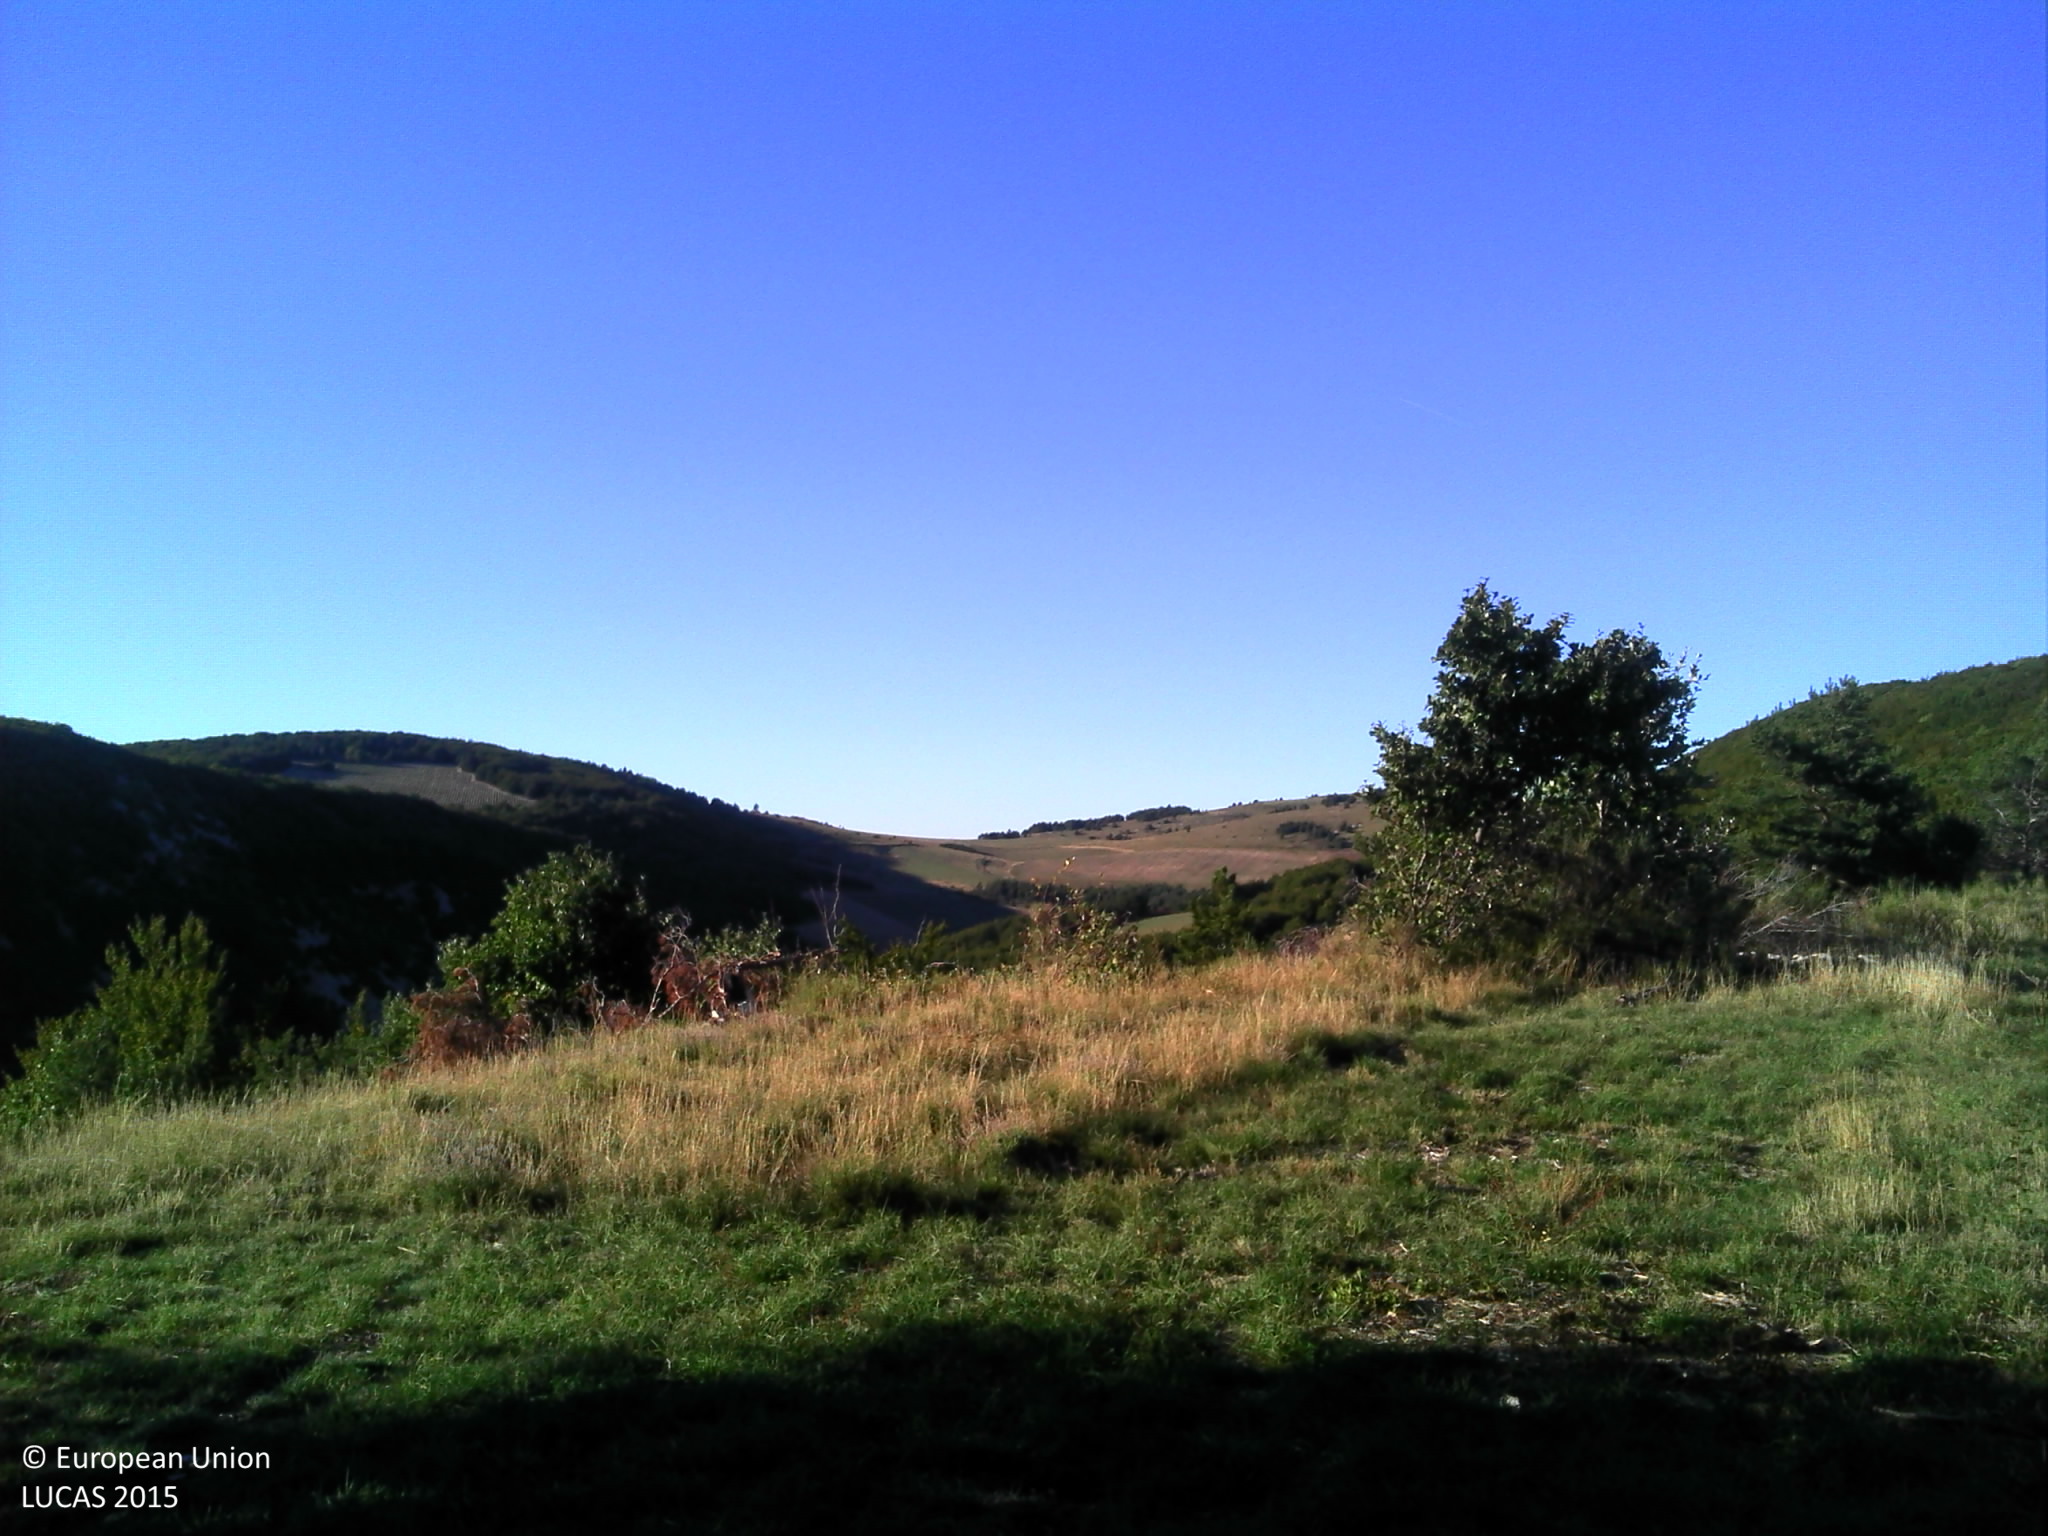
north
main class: Grassland
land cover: Grassland with sparse tree/shrub cover
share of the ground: > 75 %
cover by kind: herbaceous plants 85 %, shrubs 10 %, broadleaved forest trees 5 %
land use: Agriculture (excluding fallow land and kitchen gardens)
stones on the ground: 25 - 50 %
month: September
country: FR
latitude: 44.1455
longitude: 5.5199
